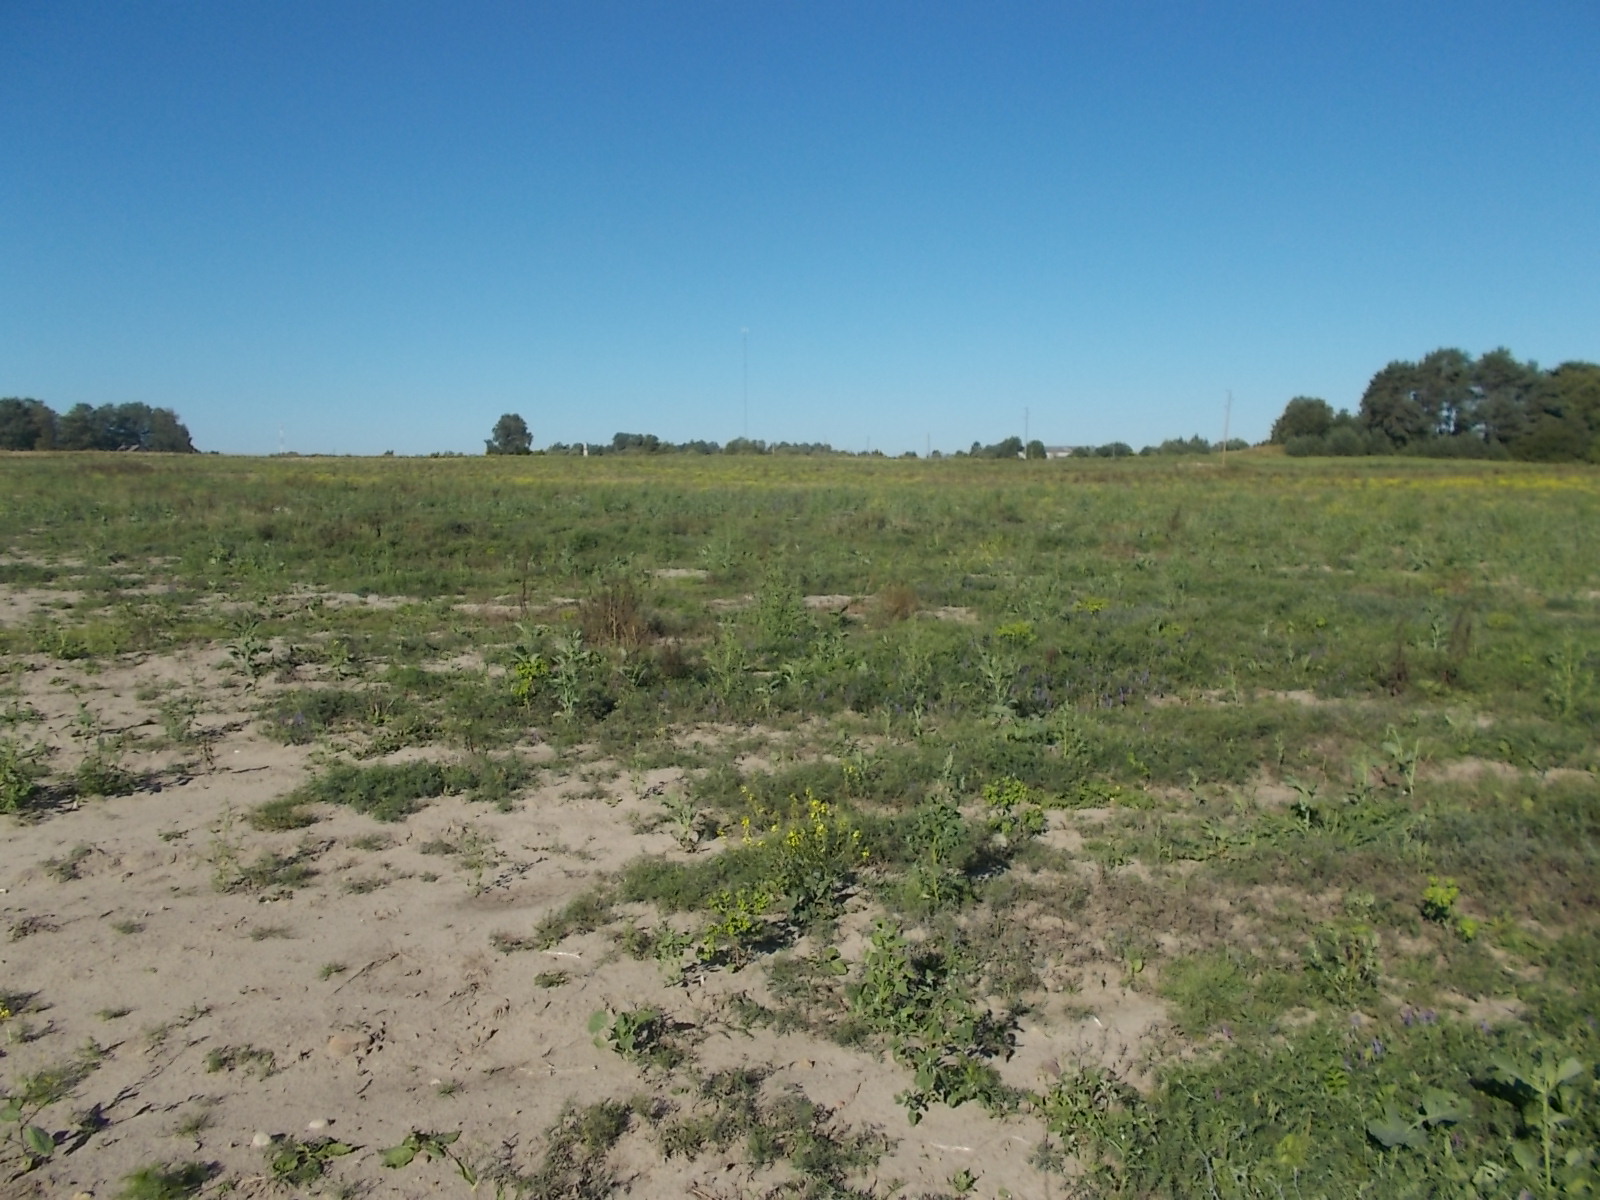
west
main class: Grassland
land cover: Spontaneously vegetated surfaces
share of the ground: 25 - 50 %
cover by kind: unconsolidated bare surface 55 %, herbaceous plants 45 %
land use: Fallow land
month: August
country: LV
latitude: 56.9265
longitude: 22.8272
